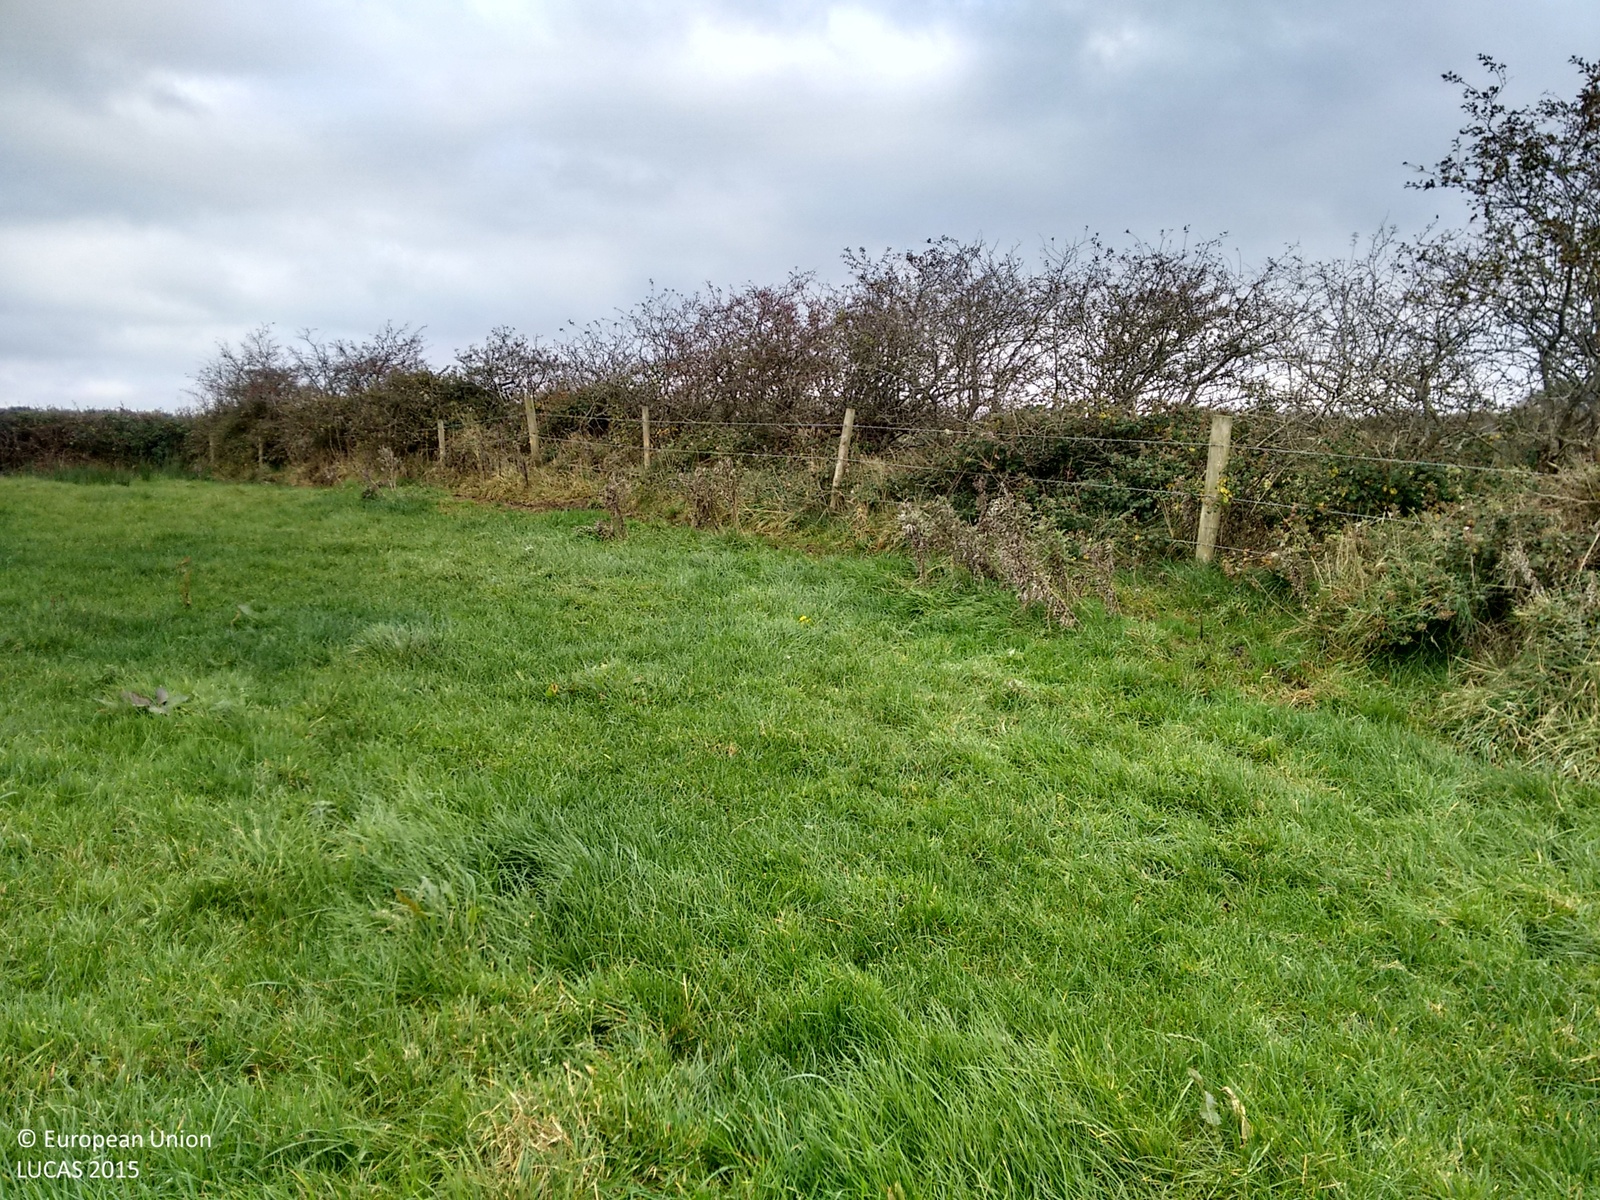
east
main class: Grassland
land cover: Grassland without tree/shrub cover
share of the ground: > 75 %
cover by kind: herbaceous plants 100 %
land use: Agriculture (excluding fallow land and kitchen gardens)
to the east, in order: Grassland without tree/shrub cover; Fences; Abandoned hedges; Ditches and canals; Fences; Grassland without tree/shrub cover; Managed hedges; Ditches and canals; Grass margins; Paved roads, cycling and walking lanes; Grass margins; Abandoned hedges; Fences; Grassland without tree/shrub cover; Fences; Abandoned hedges; Fences; Grassland without tree/shrub cover
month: November
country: IE
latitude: 54.1790
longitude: -9.0749
